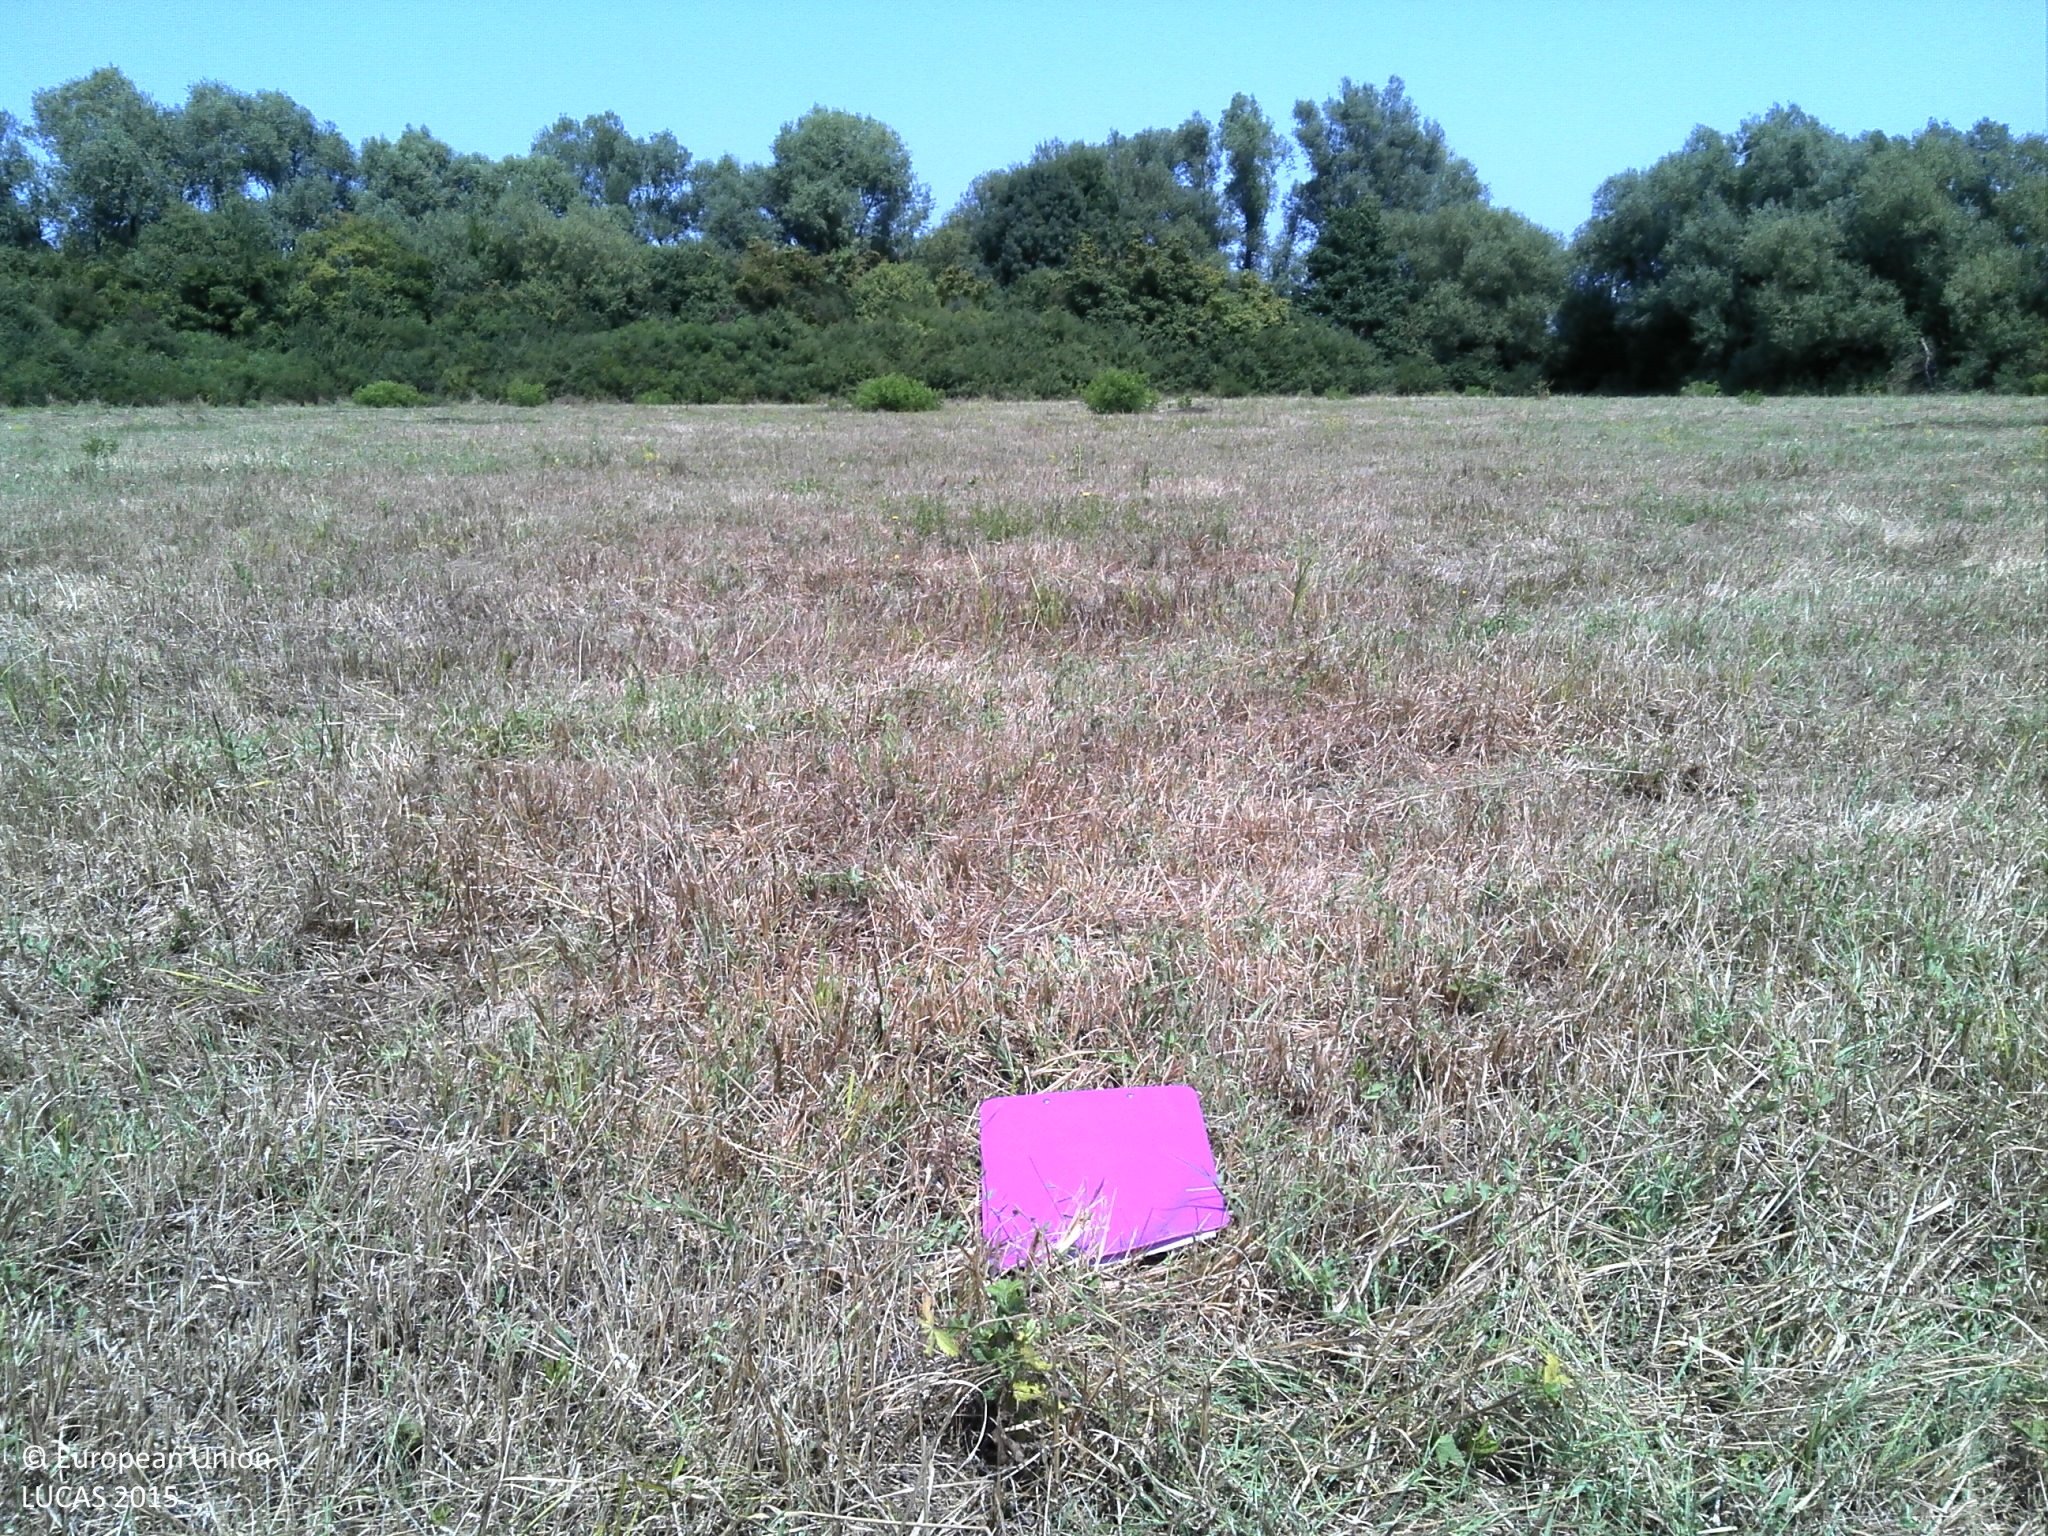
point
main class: Grassland
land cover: Grassland without tree/shrub cover
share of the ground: > 75 %
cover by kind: herbaceous plants 100 %
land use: Agriculture (excluding fallow land and kitchen gardens)
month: August
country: HR
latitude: 45.4950
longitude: 16.3320
